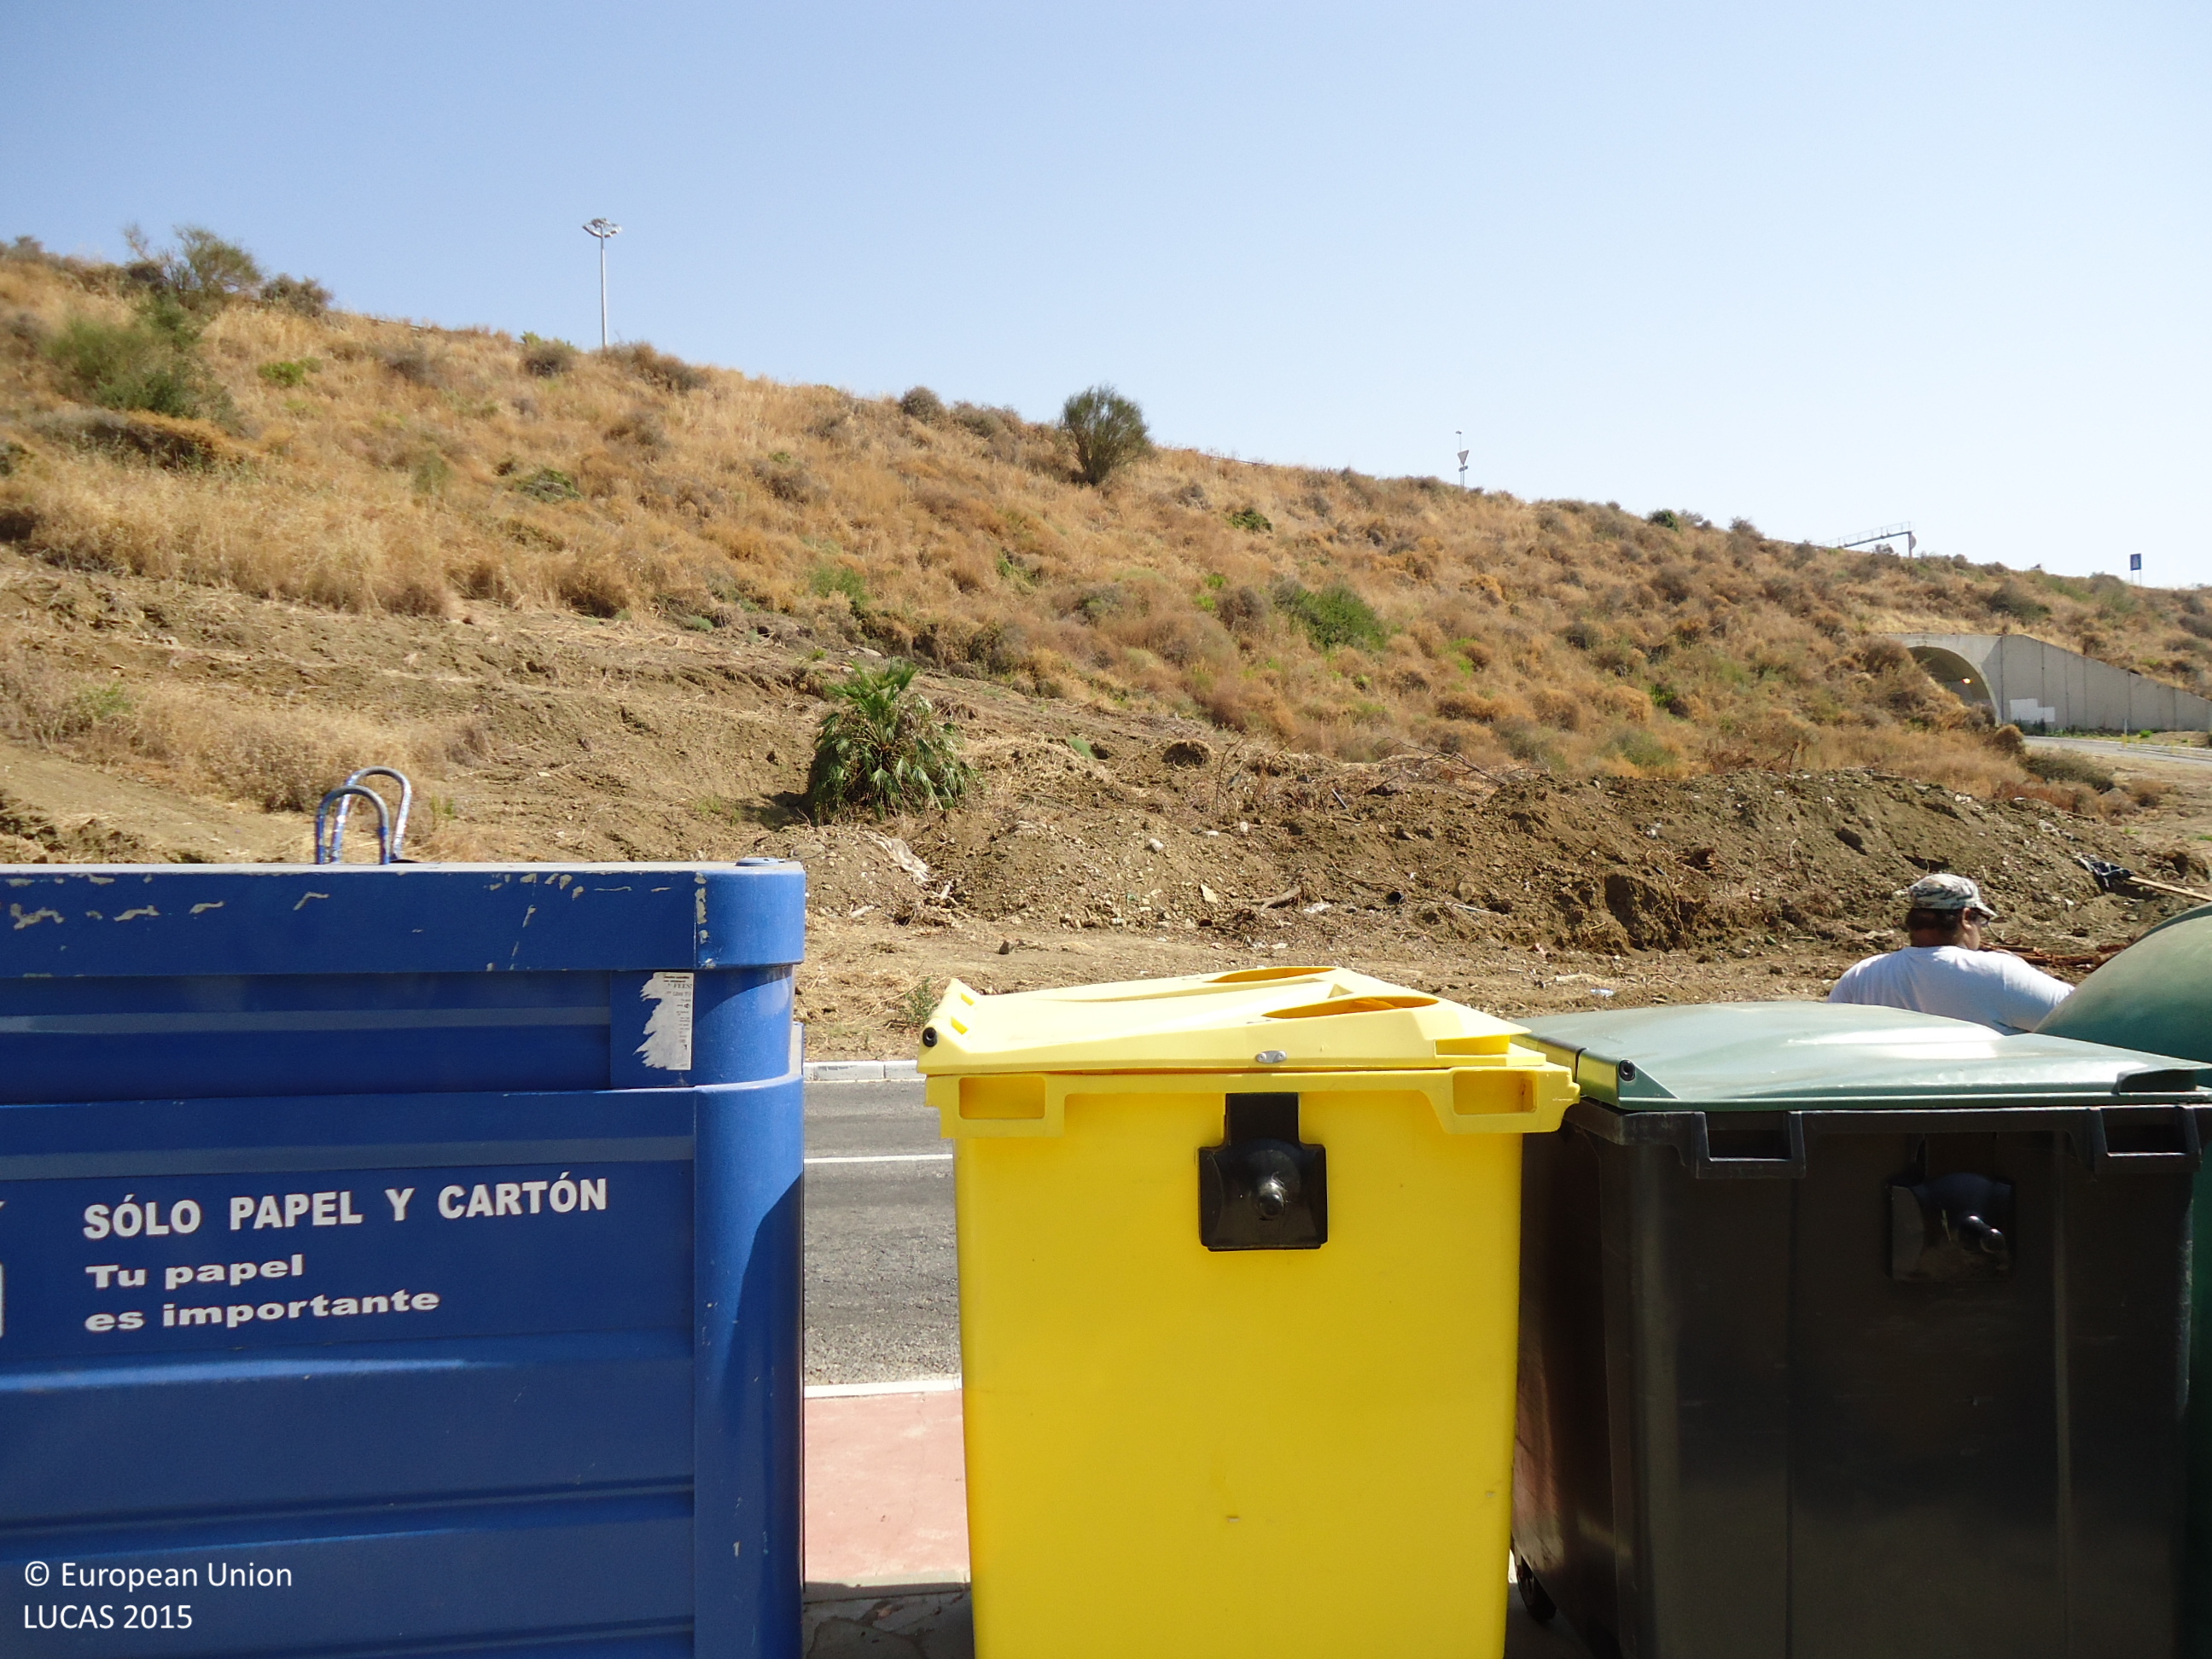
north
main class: Grassland
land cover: Grassland with sparse tree/shrub cover
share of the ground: > 75 %
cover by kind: herbaceous plants 95 %, broadleaved forest trees 5 %
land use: Residential
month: July
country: ES
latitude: 36.5039
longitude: -4.7157
